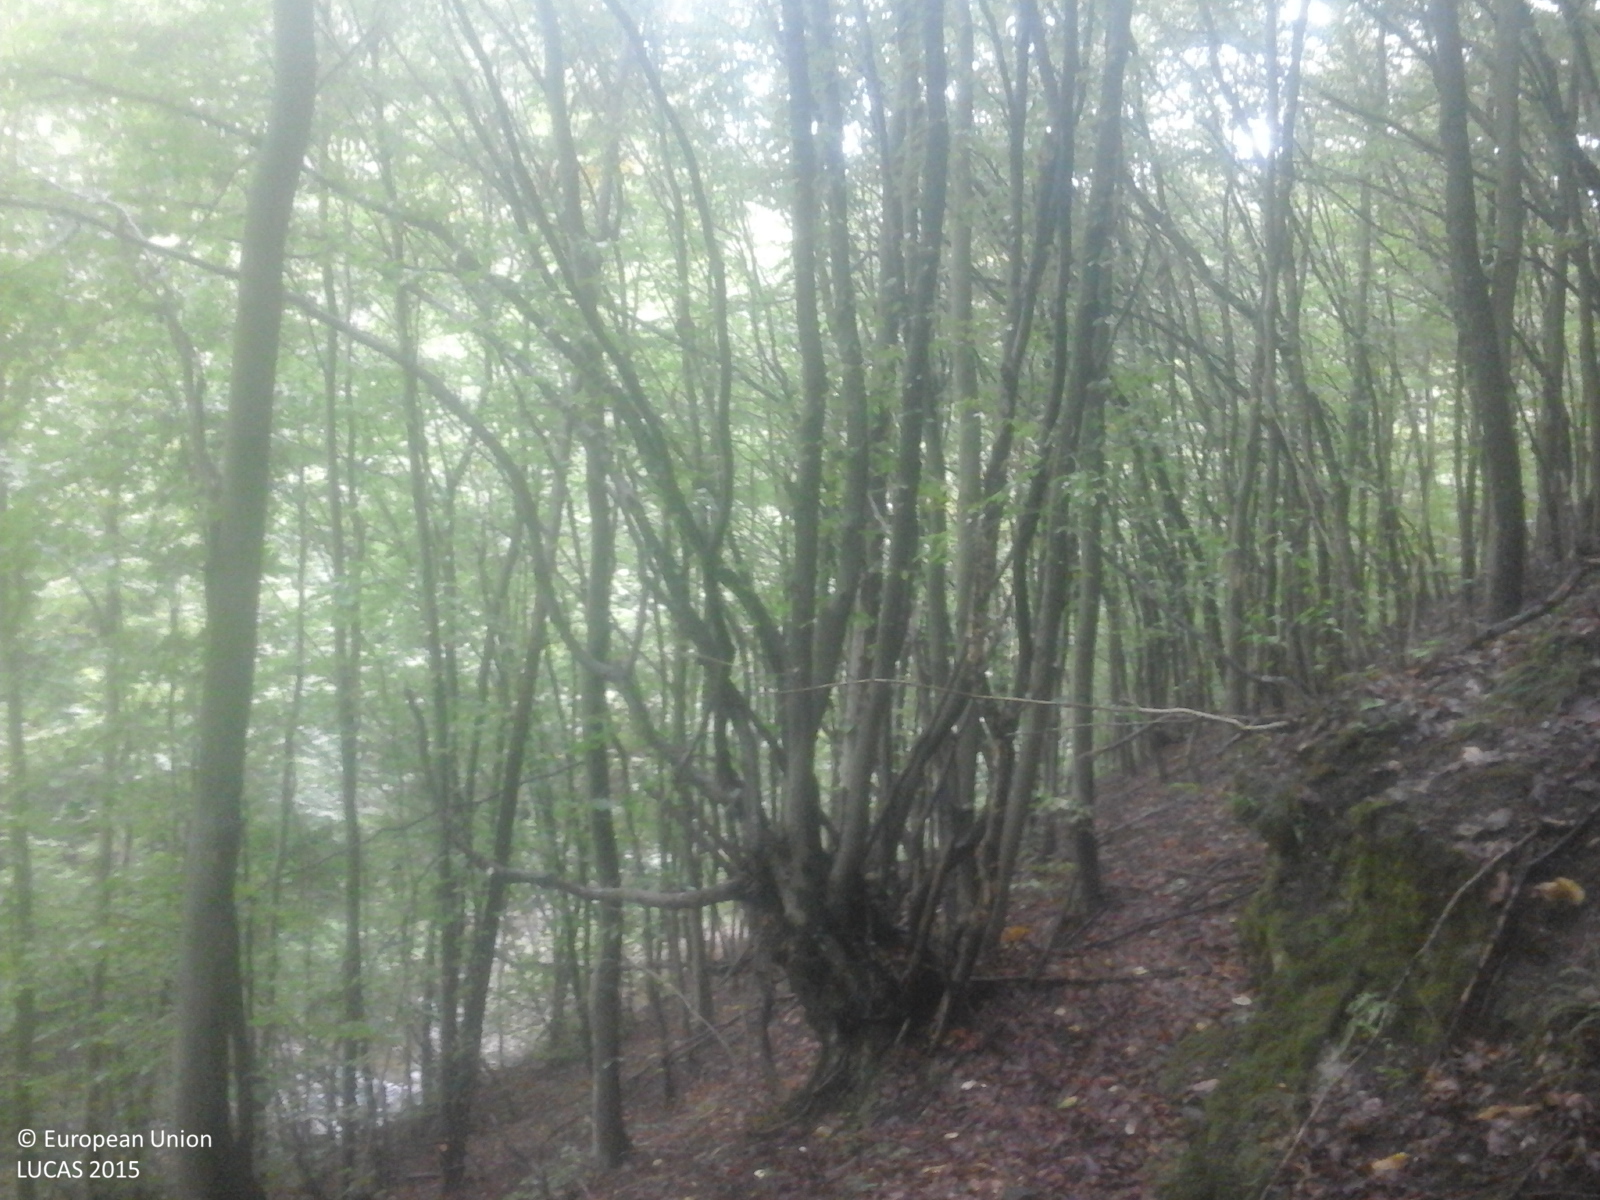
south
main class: Woodland
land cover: Broadleaved woodland
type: beech forest
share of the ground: > 75 %
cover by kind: broadleaved forest trees 100 %
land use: Forestry
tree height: > 5 m
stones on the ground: 10 - 25 %
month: September
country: RO
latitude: 45.8299
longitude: 23.6994
